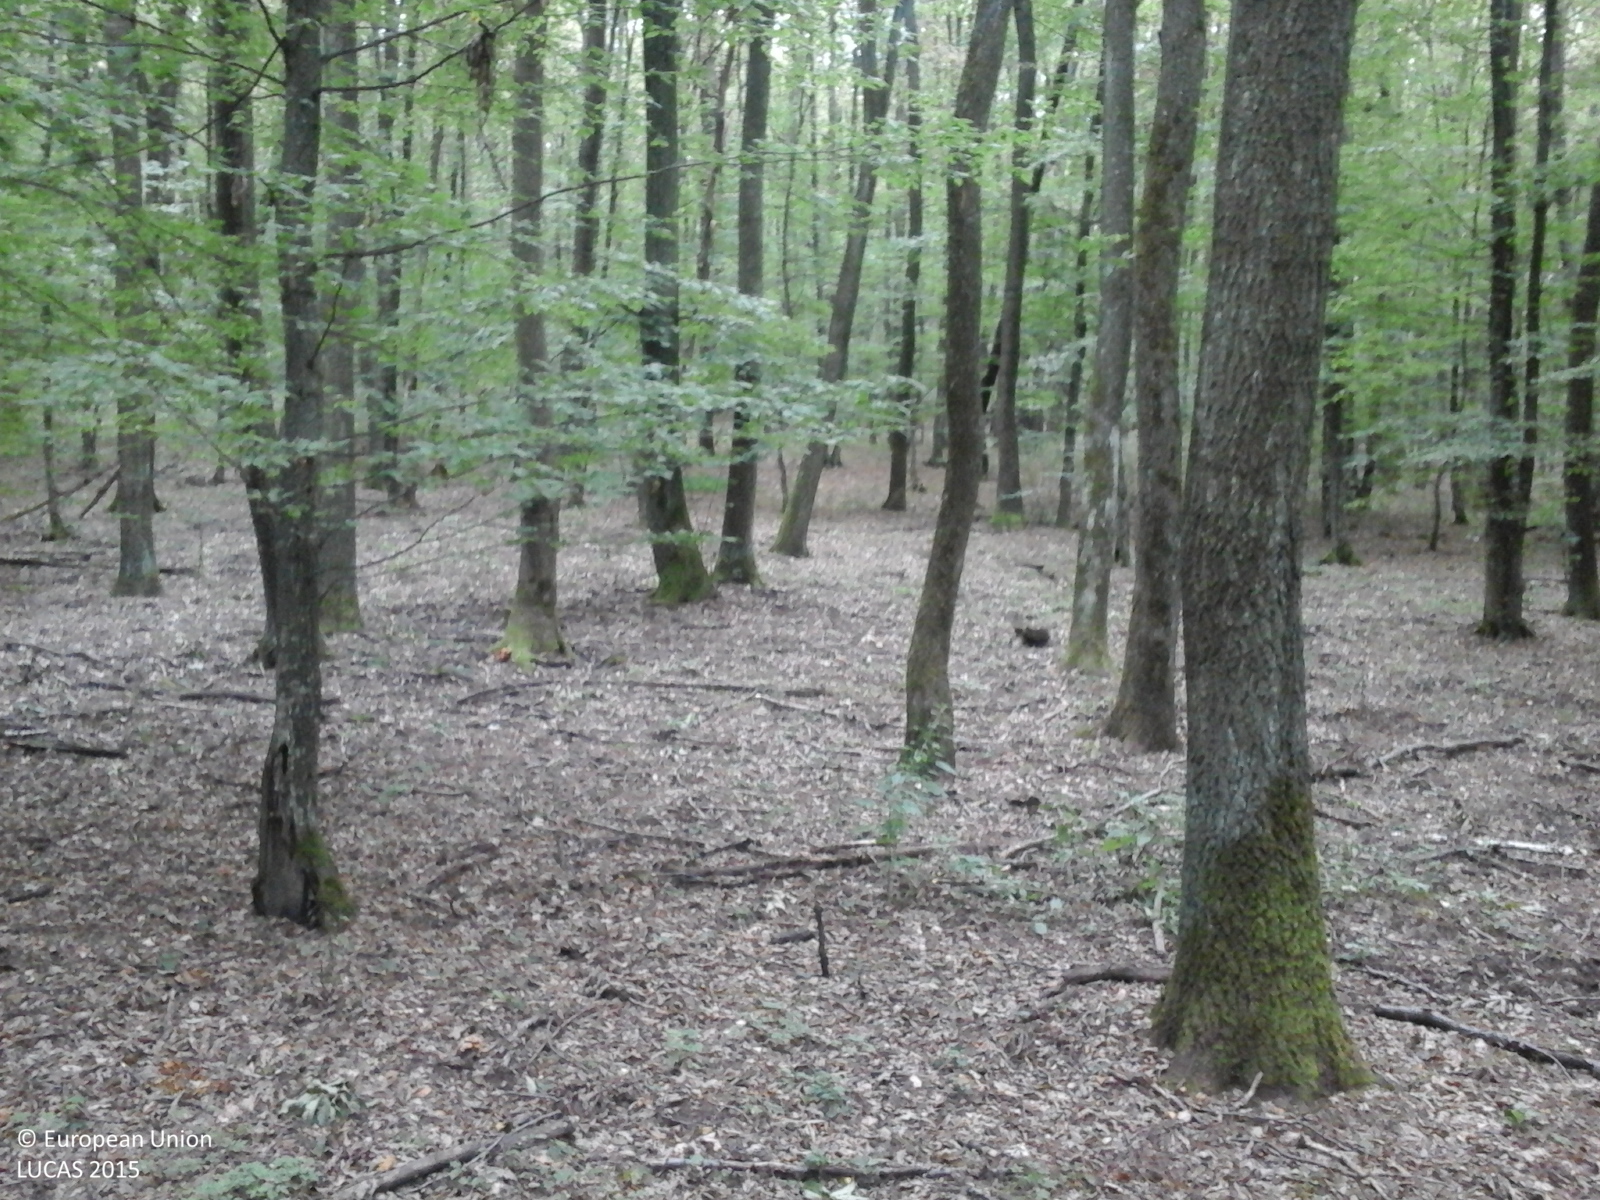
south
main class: Woodland
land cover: Broadleaved woodland
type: acidophilous oak and oak-birch forest
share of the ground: > 75 %
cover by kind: broadleaved forest trees 100 %
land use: Forestry
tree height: > 5 m
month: September
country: RO
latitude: 47.3991
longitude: 22.6596
